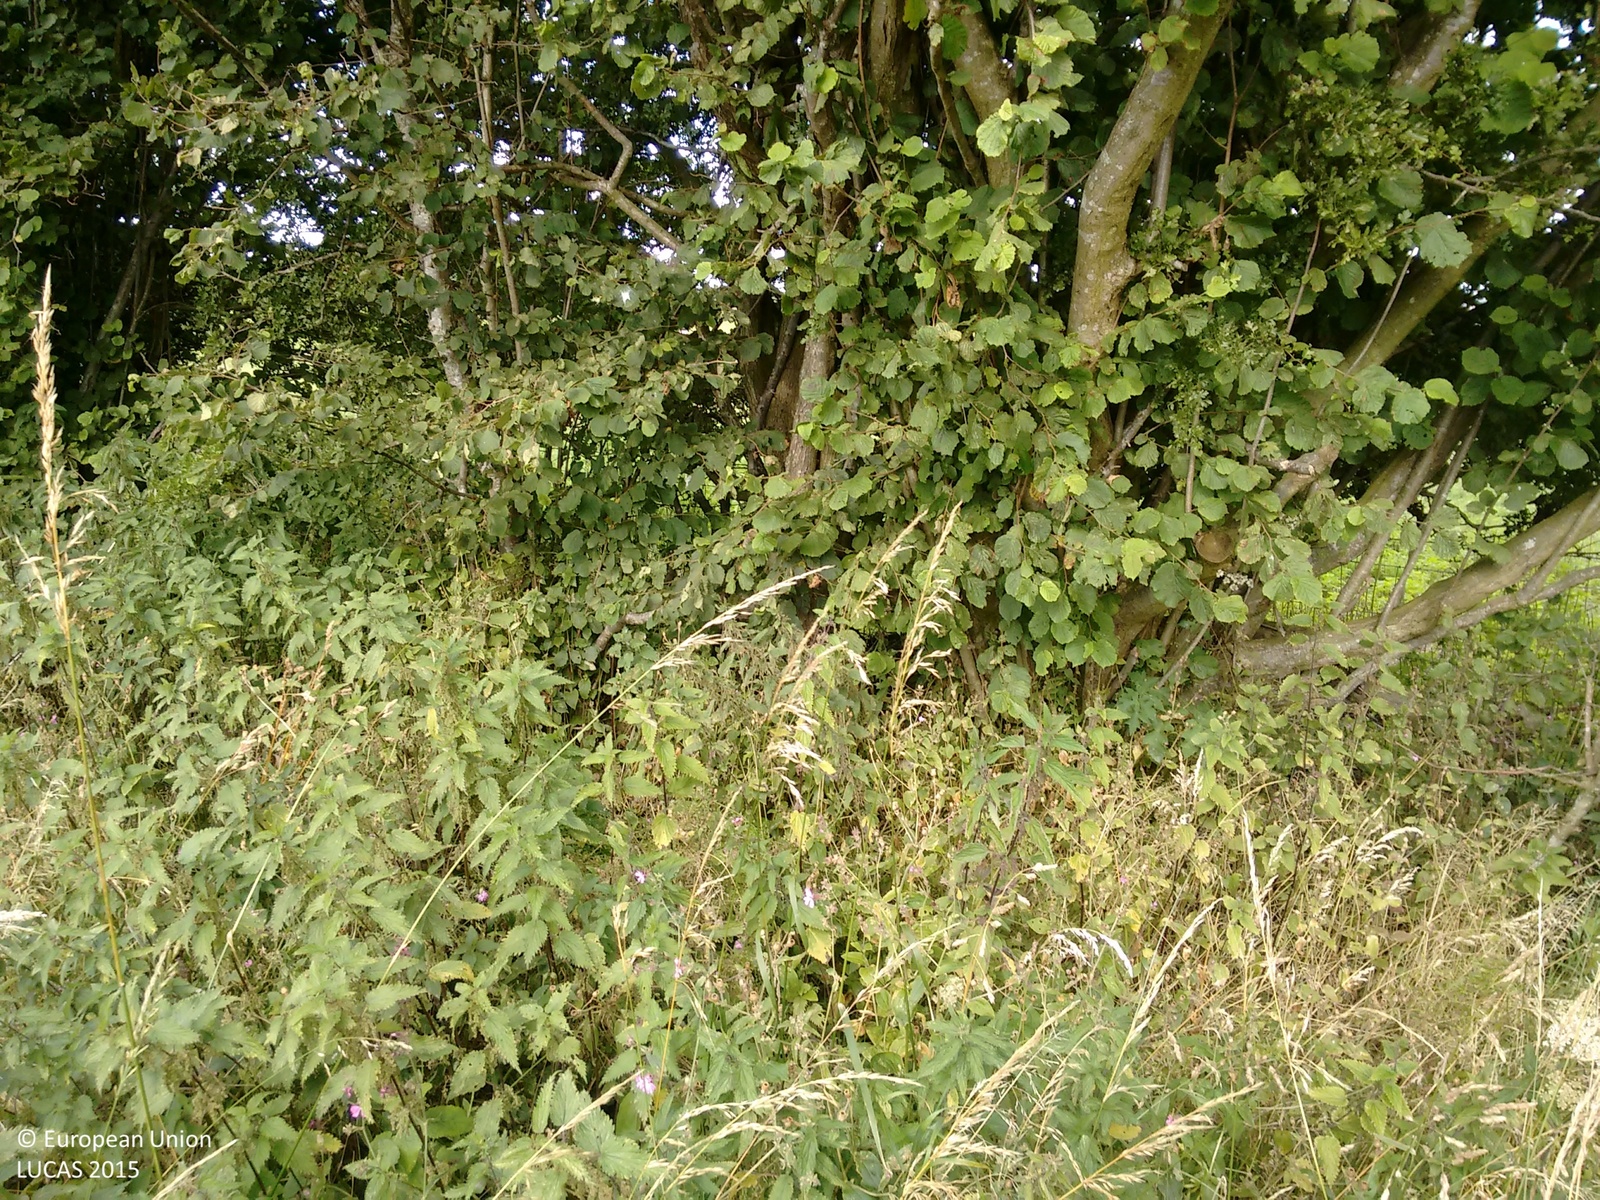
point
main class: Grassland
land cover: Grassland without tree/shrub cover
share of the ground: > 75 %
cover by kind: herbaceous plants 100 %
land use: Agriculture (excluding fallow land and kitchen gardens)
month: August
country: GB
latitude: 54.7160
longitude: -3.3827
